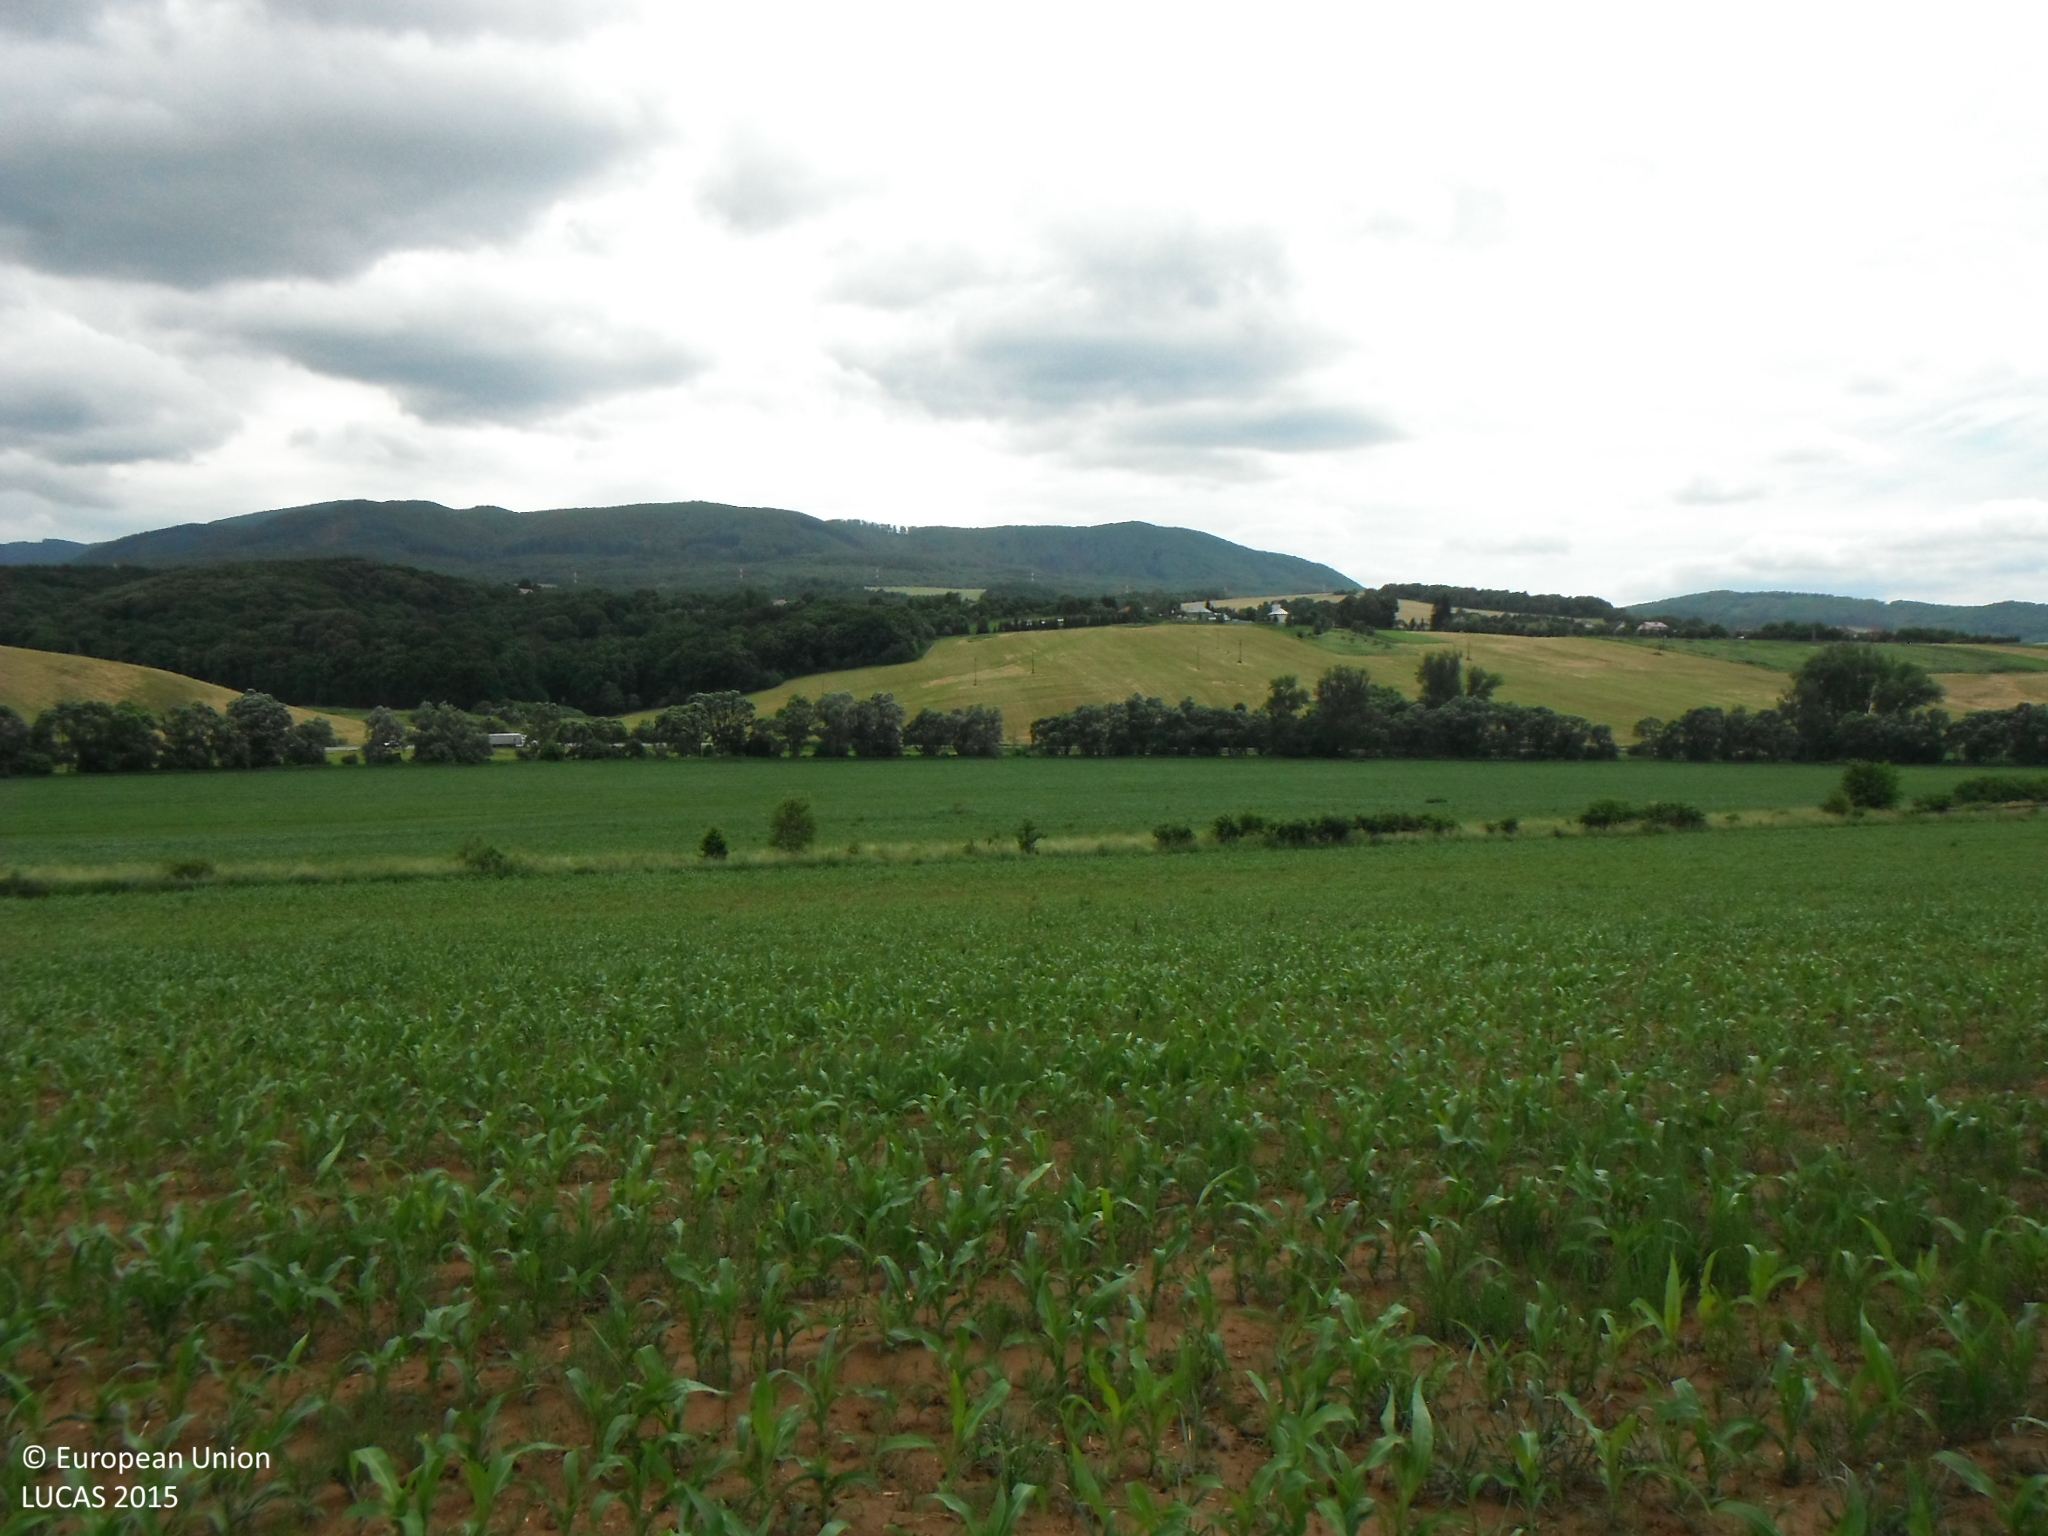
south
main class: Cropland
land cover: Maize
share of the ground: 25 - 50 %
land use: Agriculture (excluding fallow land and kitchen gardens)
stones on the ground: < 10 %
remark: Temporary flooded
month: June
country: SK
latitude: 49.0483
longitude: 21.3895
